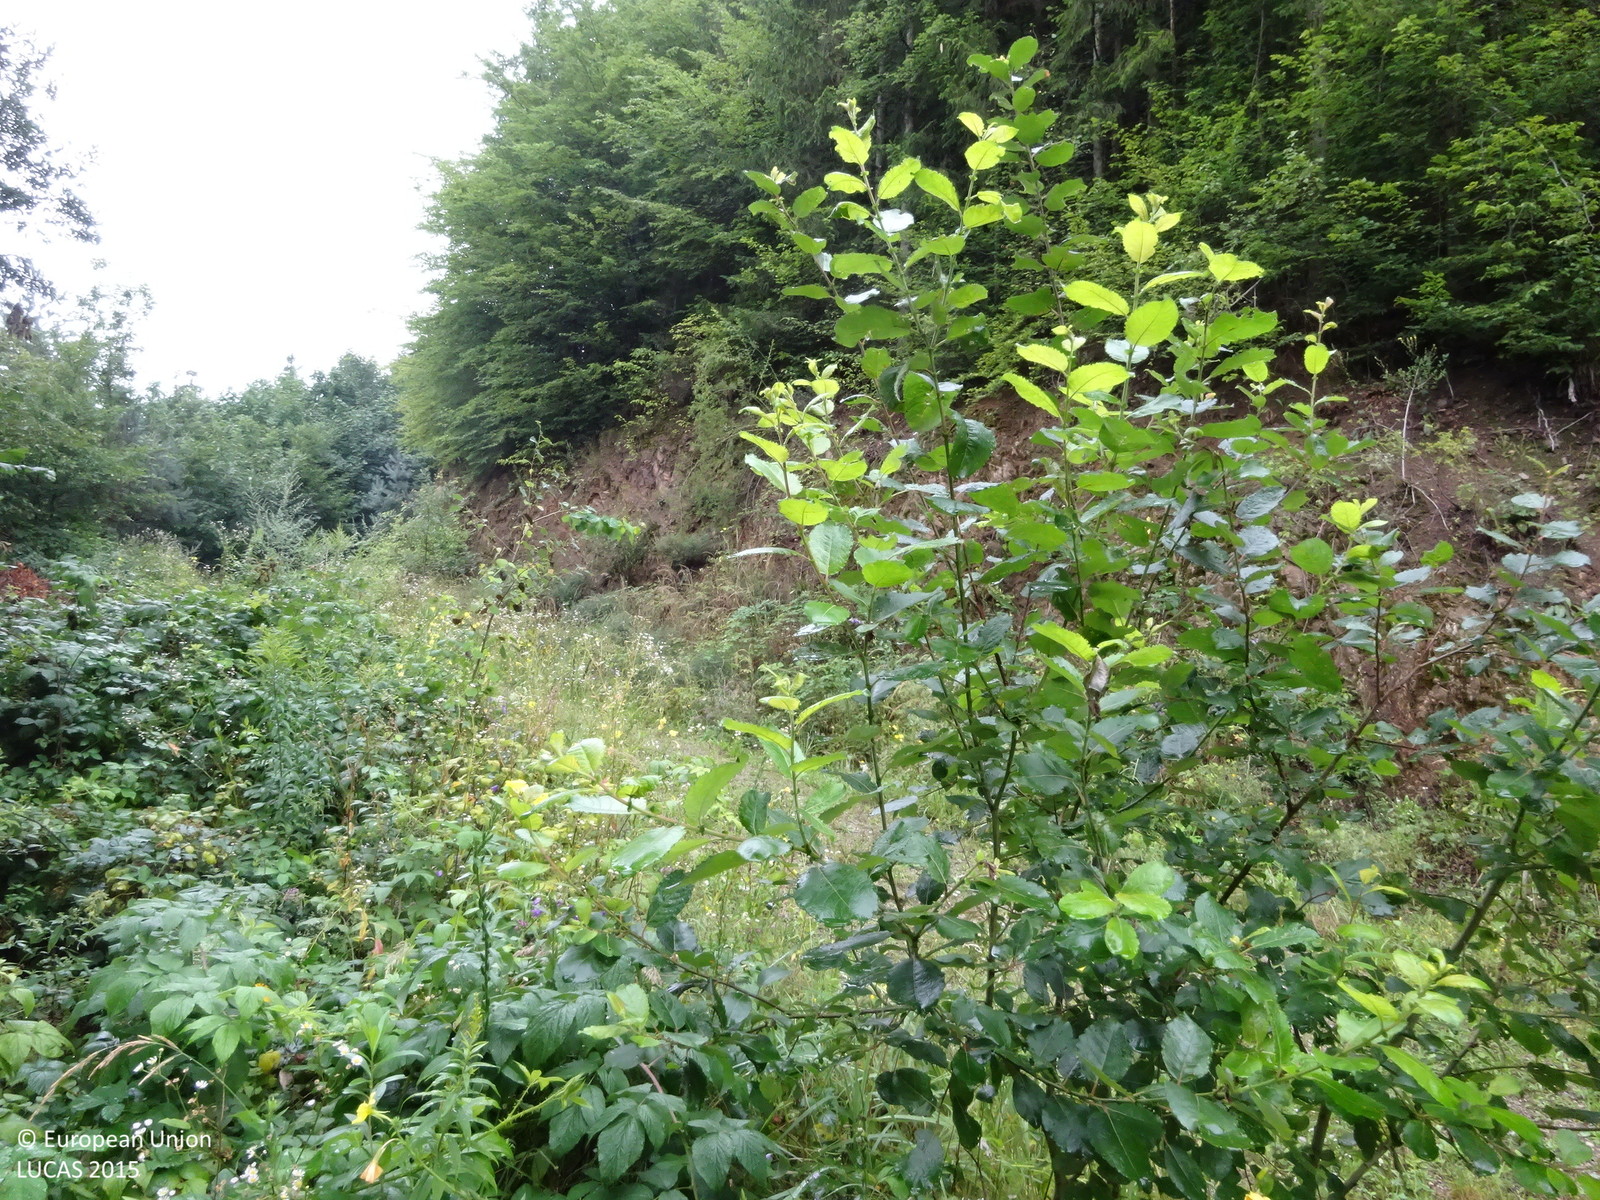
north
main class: Grassland
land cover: Spontaneously vegetated surfaces
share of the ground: > 75 %
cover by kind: herbaceous plants 100 %
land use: Forestry
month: July
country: AT
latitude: 47.3356
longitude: 15.3601
